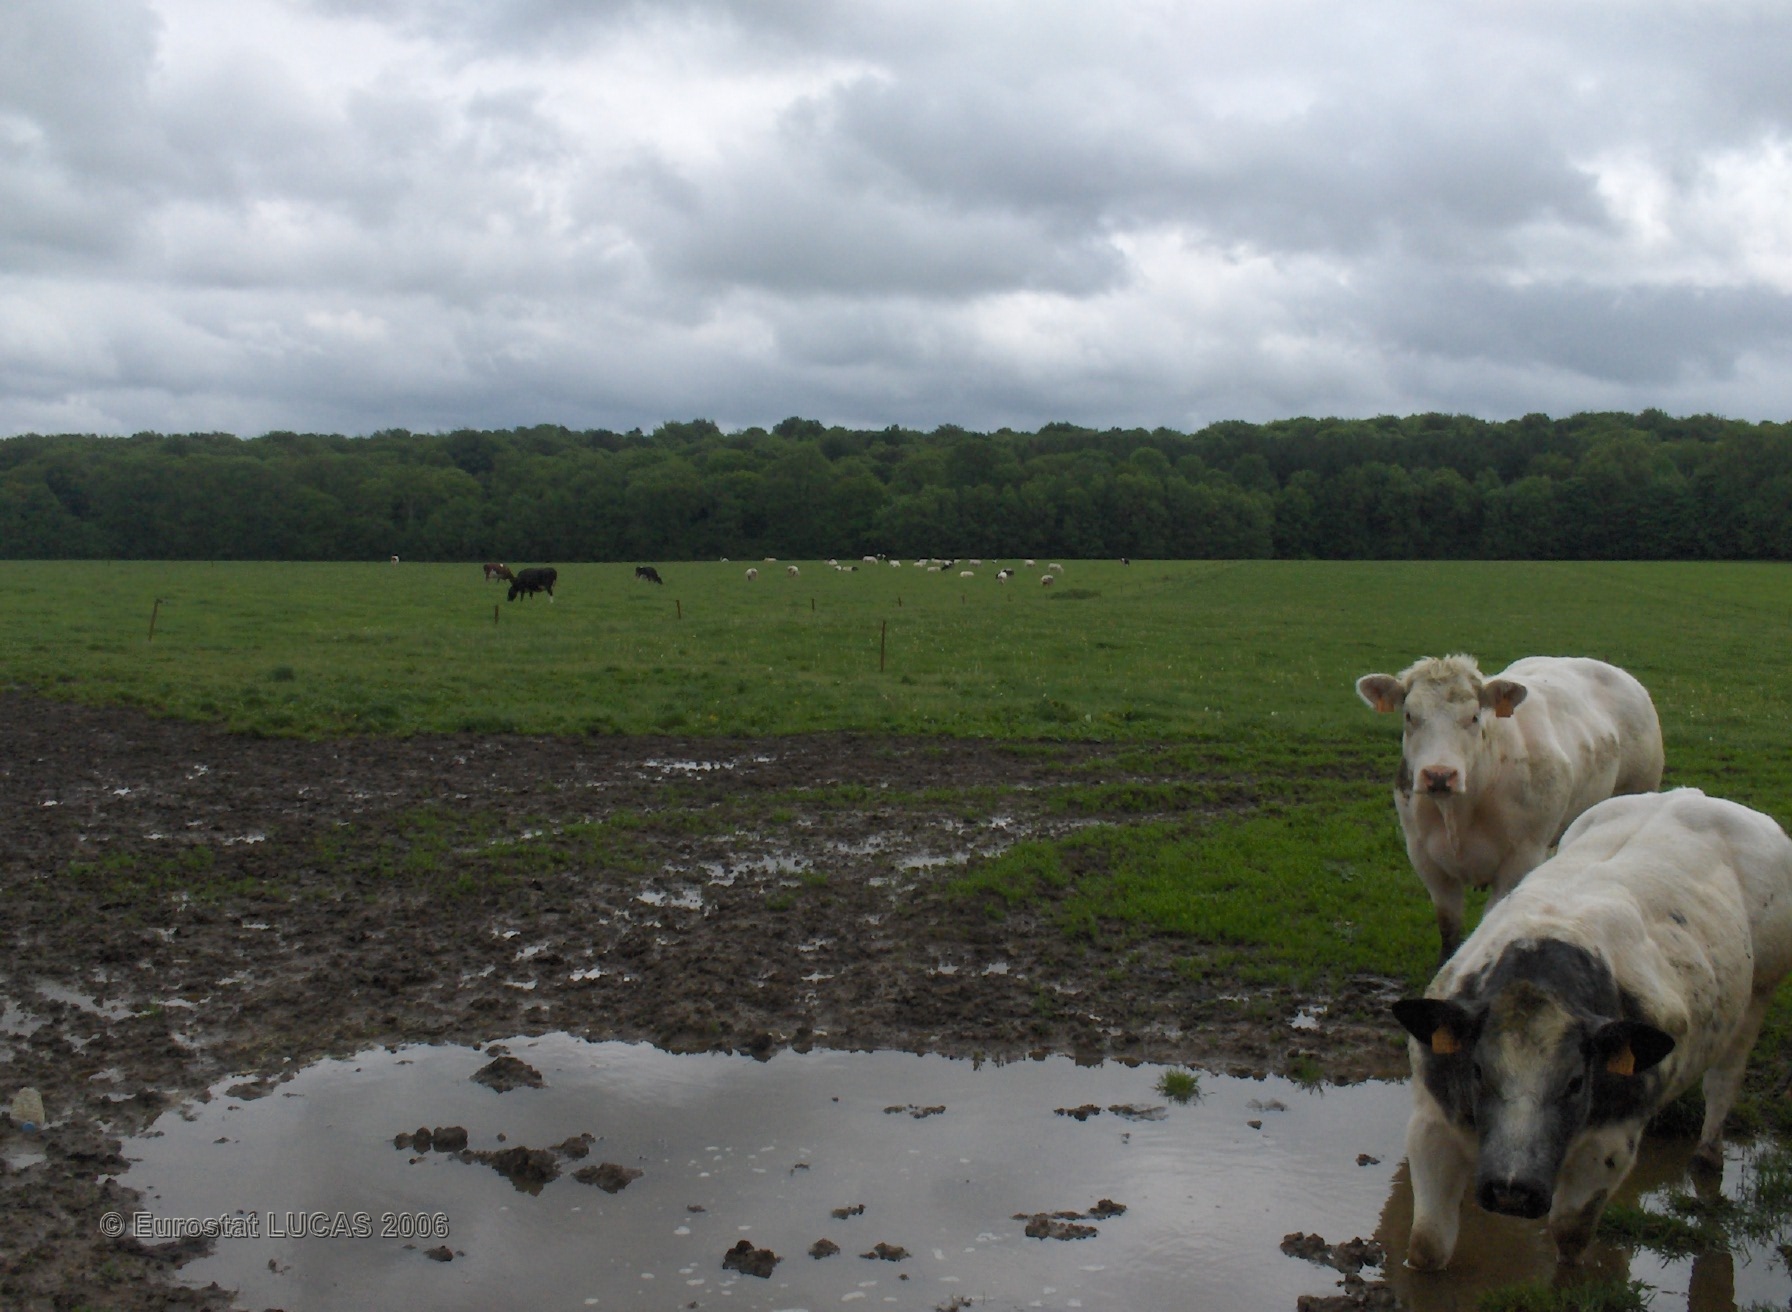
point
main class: Grassland
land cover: Grassland without tree/shrub cover
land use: Agriculture (excluding fallow land and kitchen gardens)
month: May
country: BE
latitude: 50.4098
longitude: 5.2557
